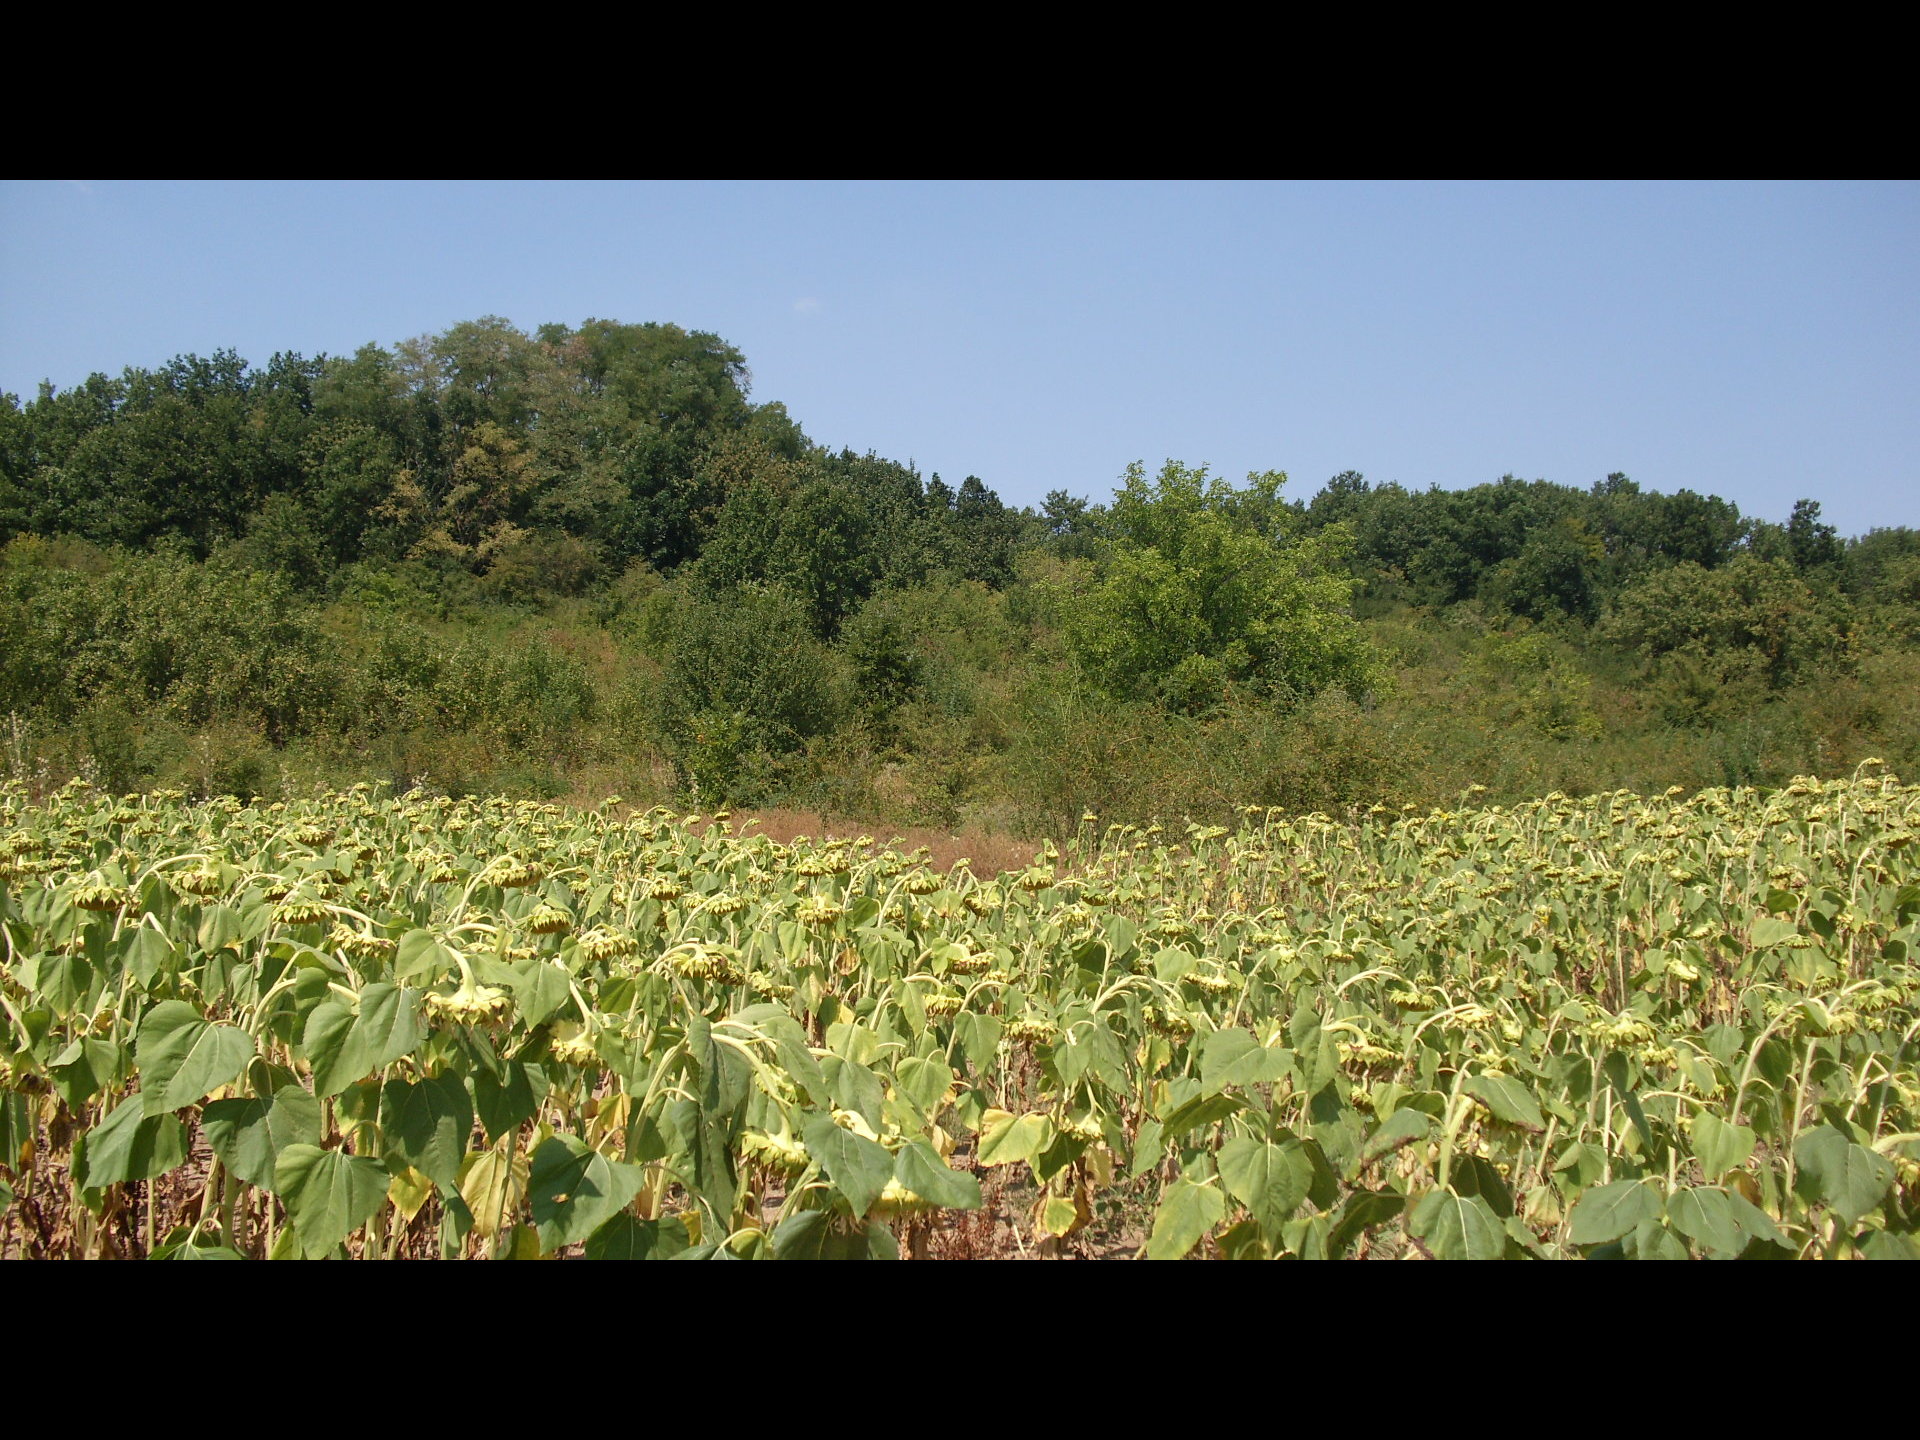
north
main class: Shrubland
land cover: Shrubland without tree cover
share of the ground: > 75 %
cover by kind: shrubs 95 %, herbaceous plants 5 %
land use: Agriculture (excluding fallow land and kitchen gardens)
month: August
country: BG
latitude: 43.2988
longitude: 23.3658
